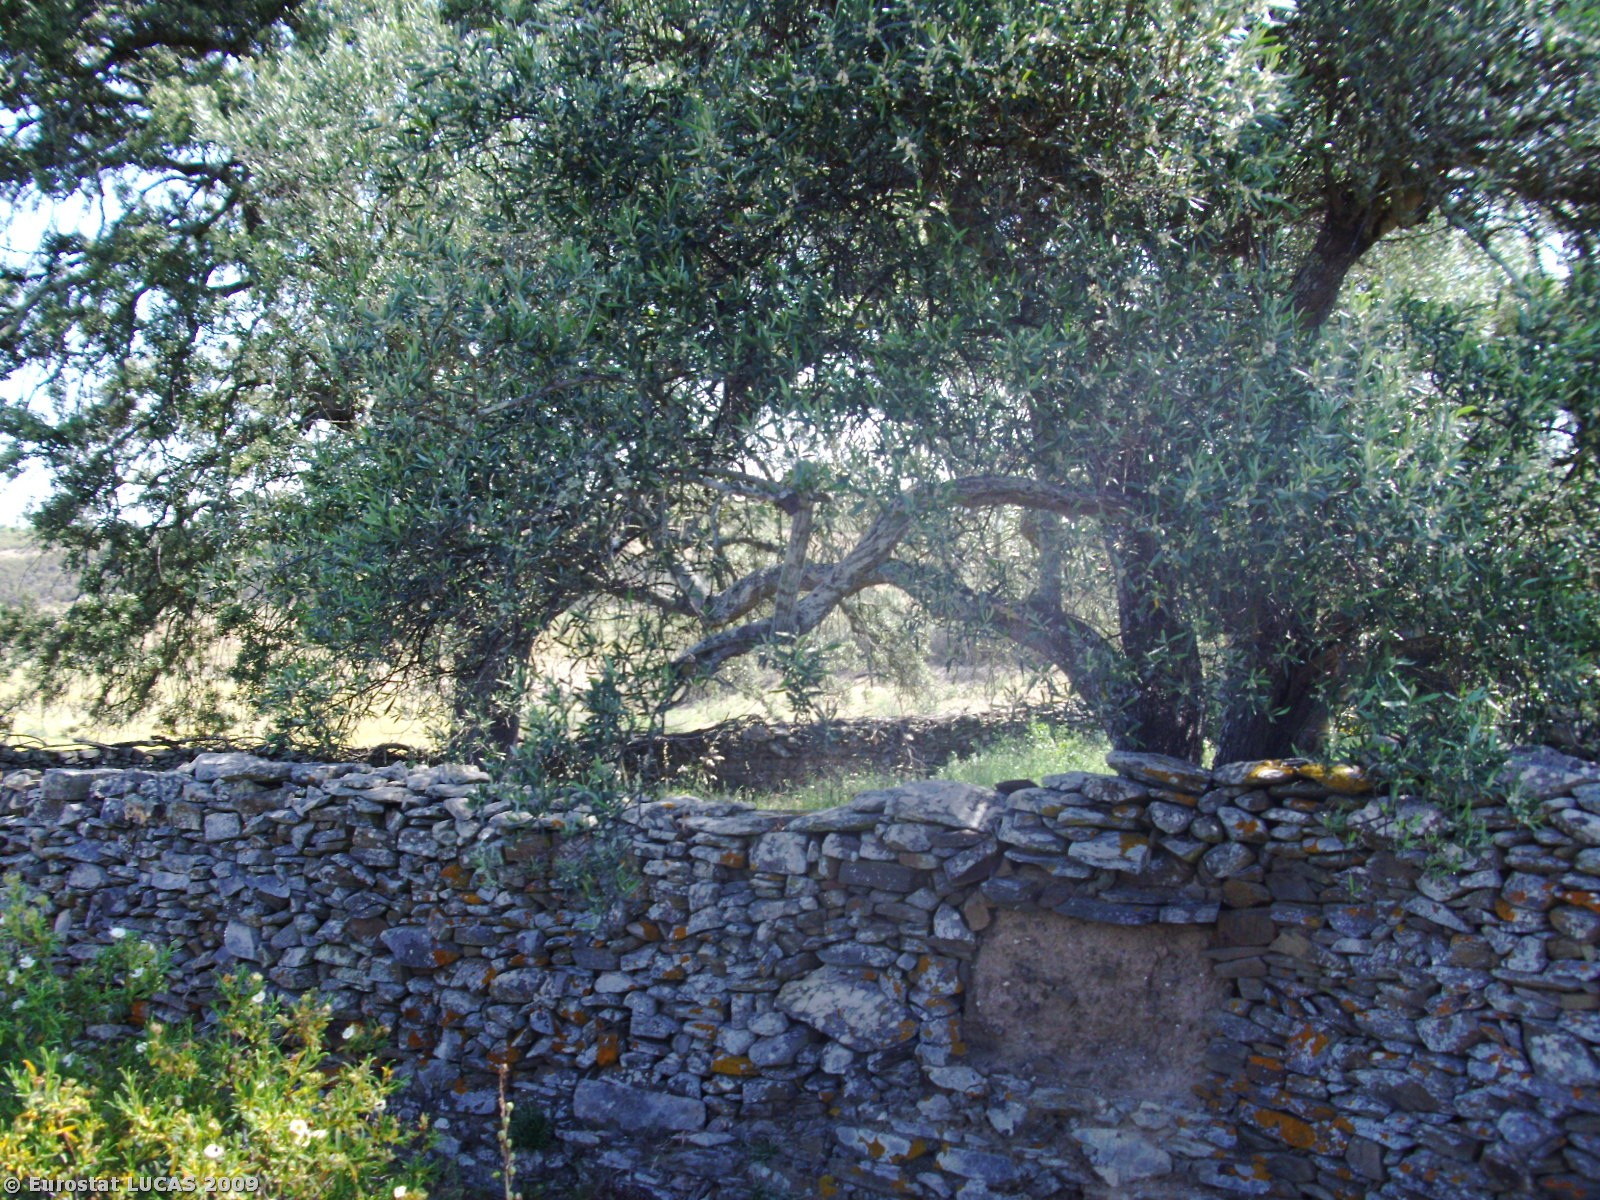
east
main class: Shrubland
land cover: Shrubland without tree cover
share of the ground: 50 - 75 %
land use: Unused
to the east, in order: Shrubland without tree cover; Abandoned hedges; Ditches and canals; Dry stone walls; Grassland with sparse tree/shrub cover; Dry stone walls; Ditches and canals; Grassland without tree/shrub cover; Dry stone walls; Ditches and canals; Spontaneously vegetated surfaces; Fences; Grassland without tree/shrub cover
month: May
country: PT
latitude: 37.5424
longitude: -7.6582
